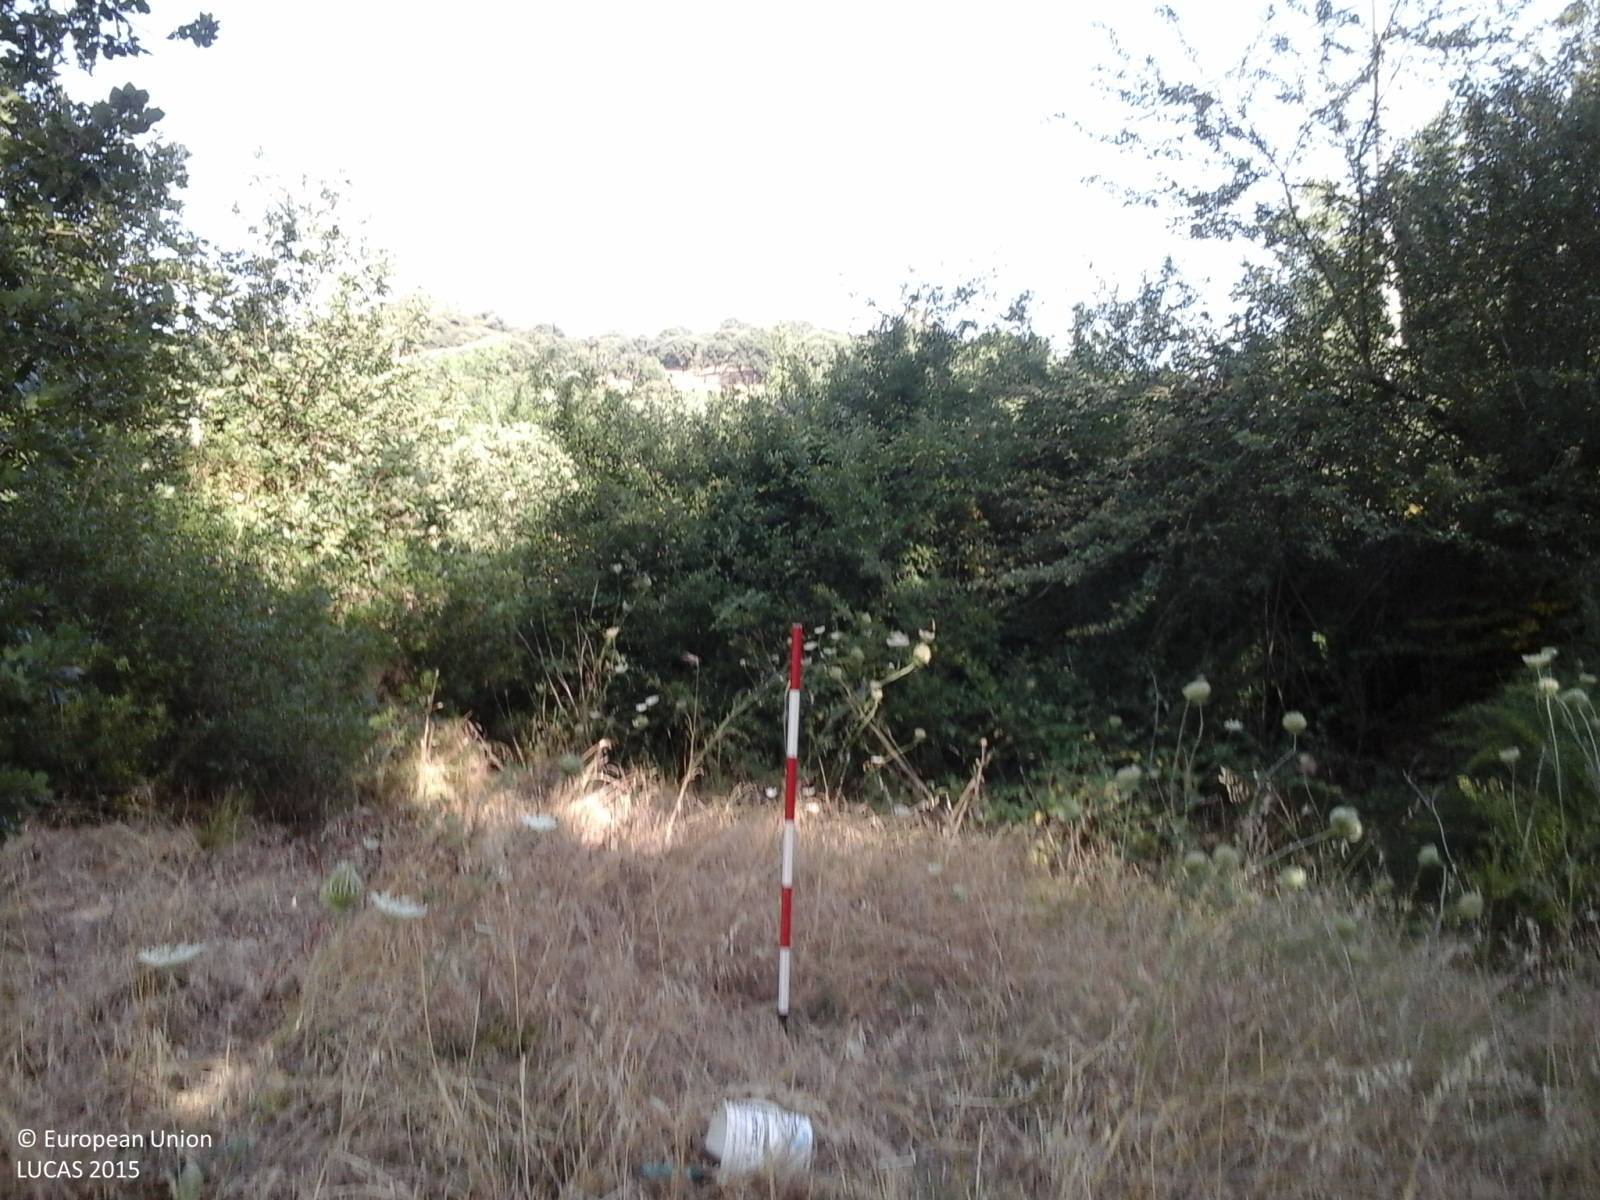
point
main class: Woodland
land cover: Broadleaved woodland
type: broadleaved evergreen forest
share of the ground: 25 - 50 %
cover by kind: broadleaved forest trees 50 %, herbaceous plants 50 %
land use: Agriculture (excluding fallow land and kitchen gardens)
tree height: < 5 m
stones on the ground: < 10 %
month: July
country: IT
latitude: 40.0254
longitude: 8.8696
